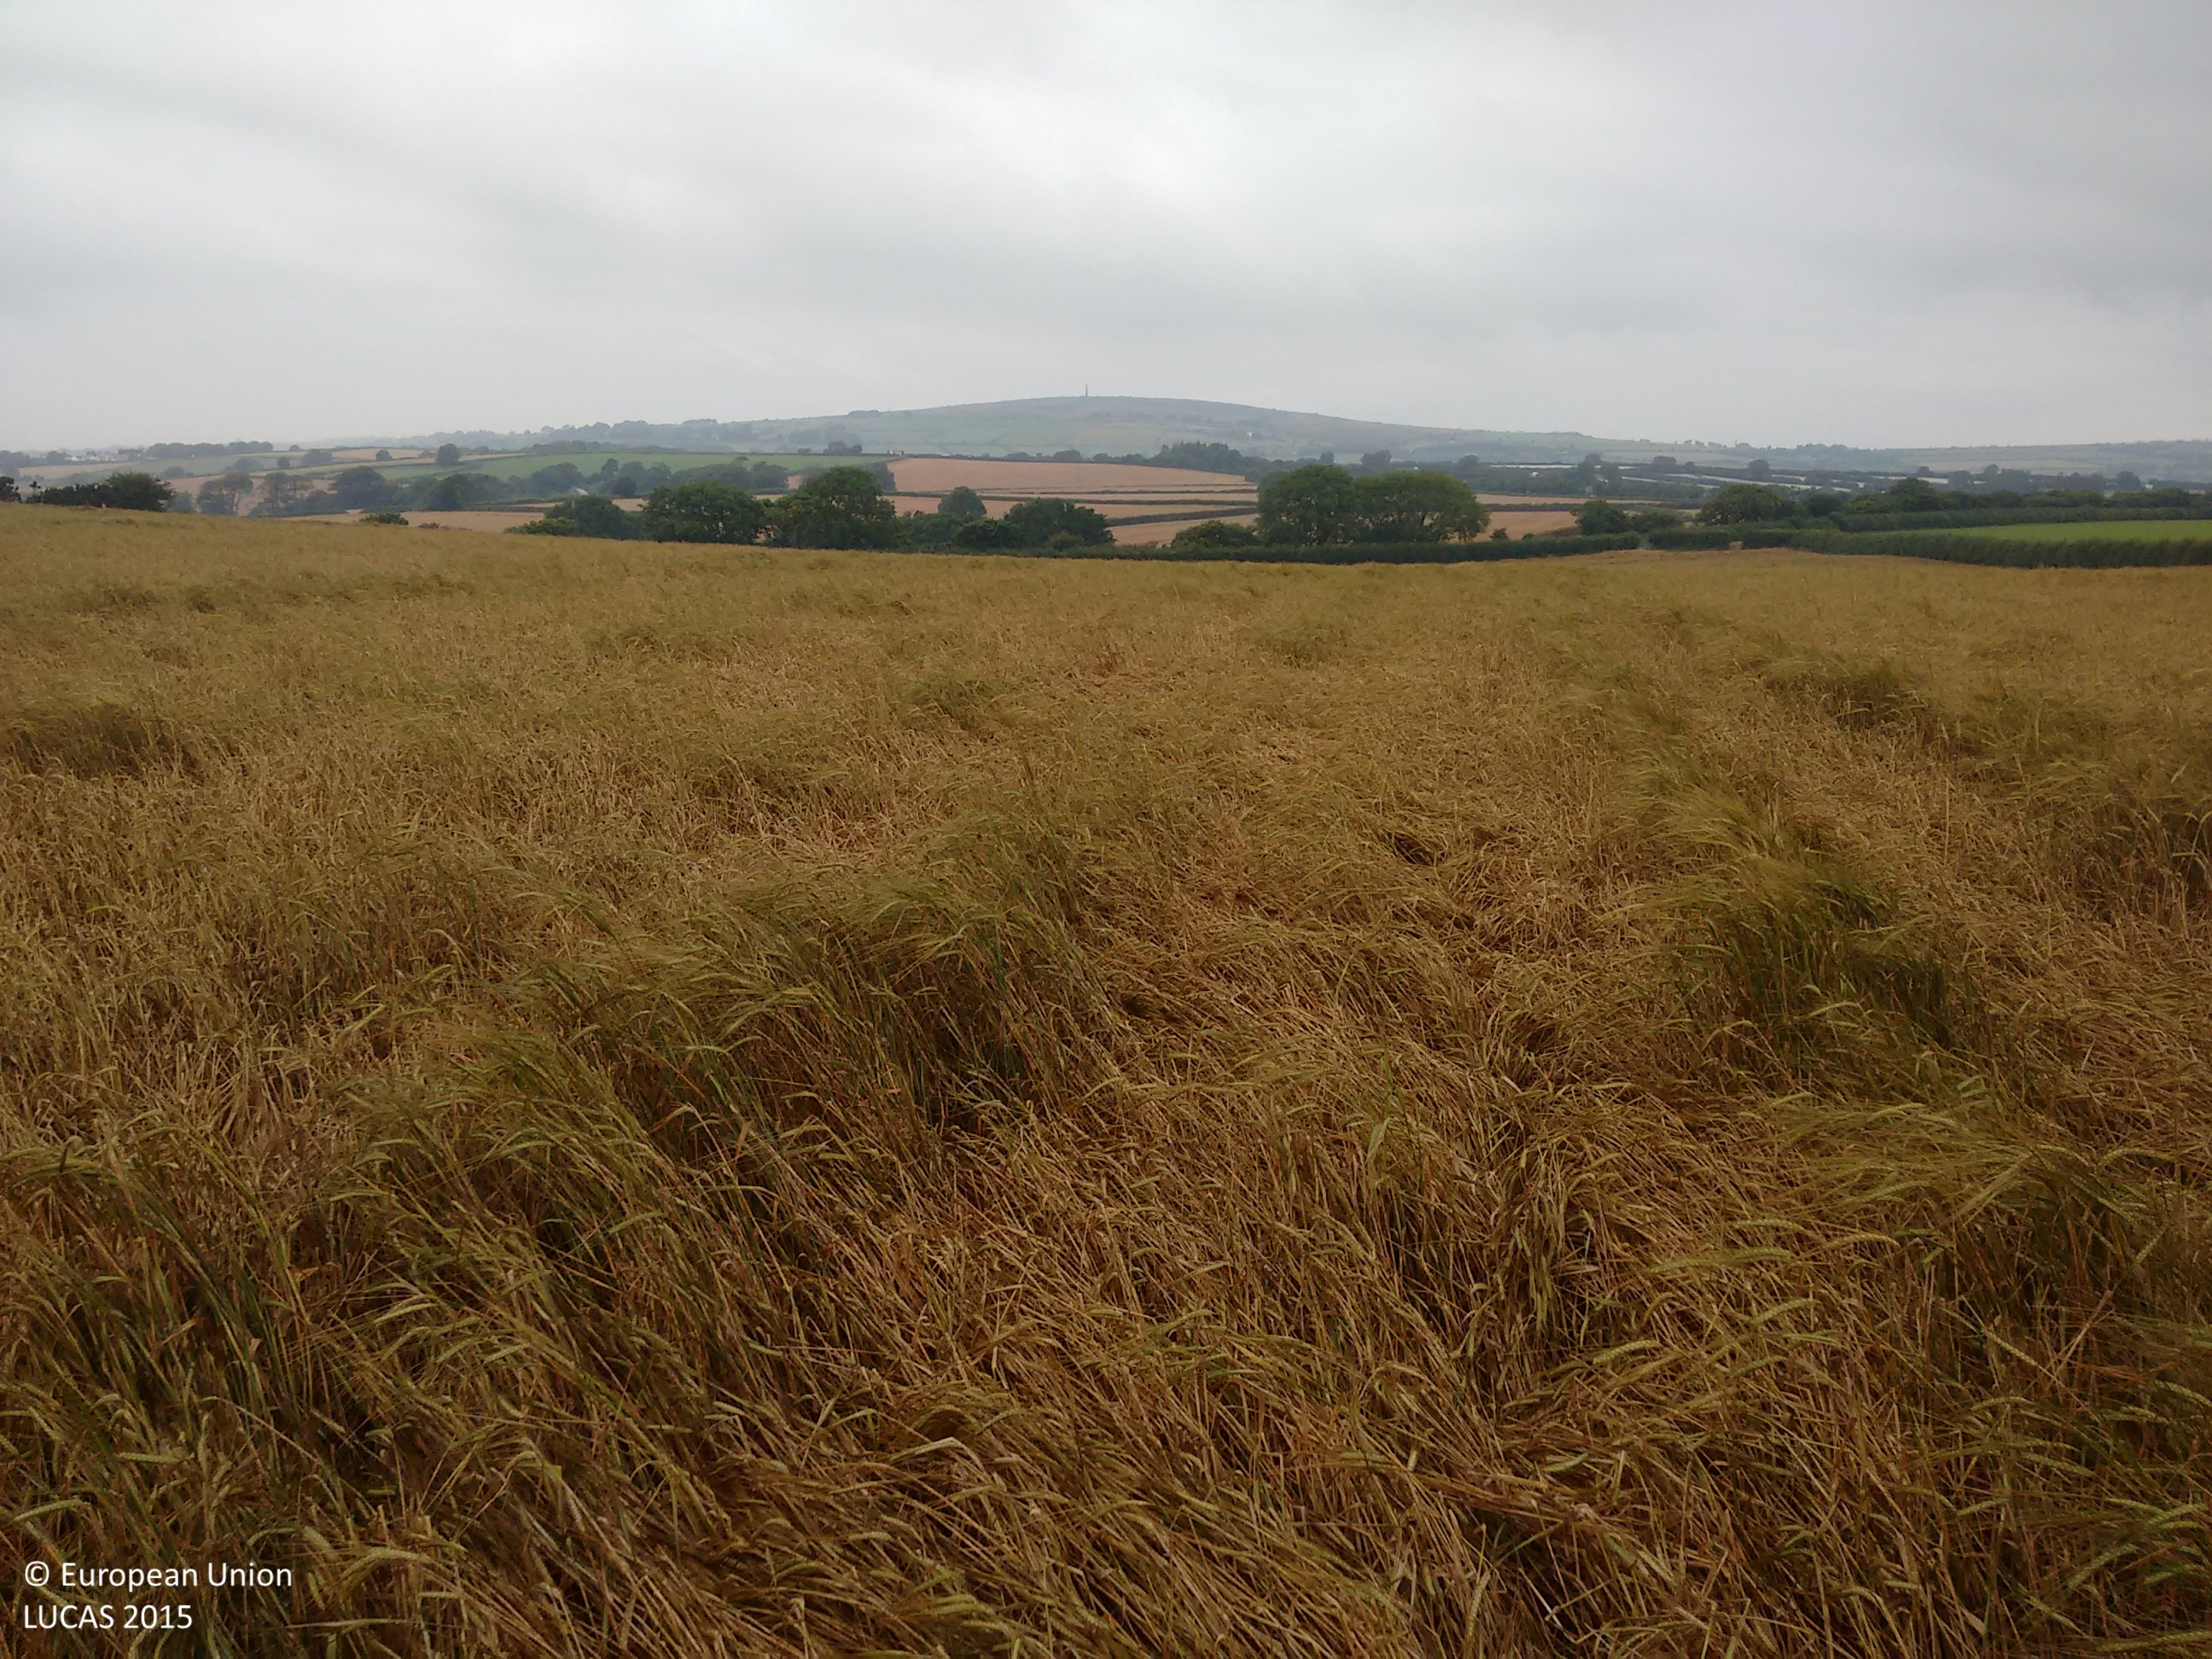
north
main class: Cropland
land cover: Barley
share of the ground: > 75 %
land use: Agriculture (excluding fallow land and kitchen gardens)
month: August
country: GB
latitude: 50.4835
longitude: -4.2919
